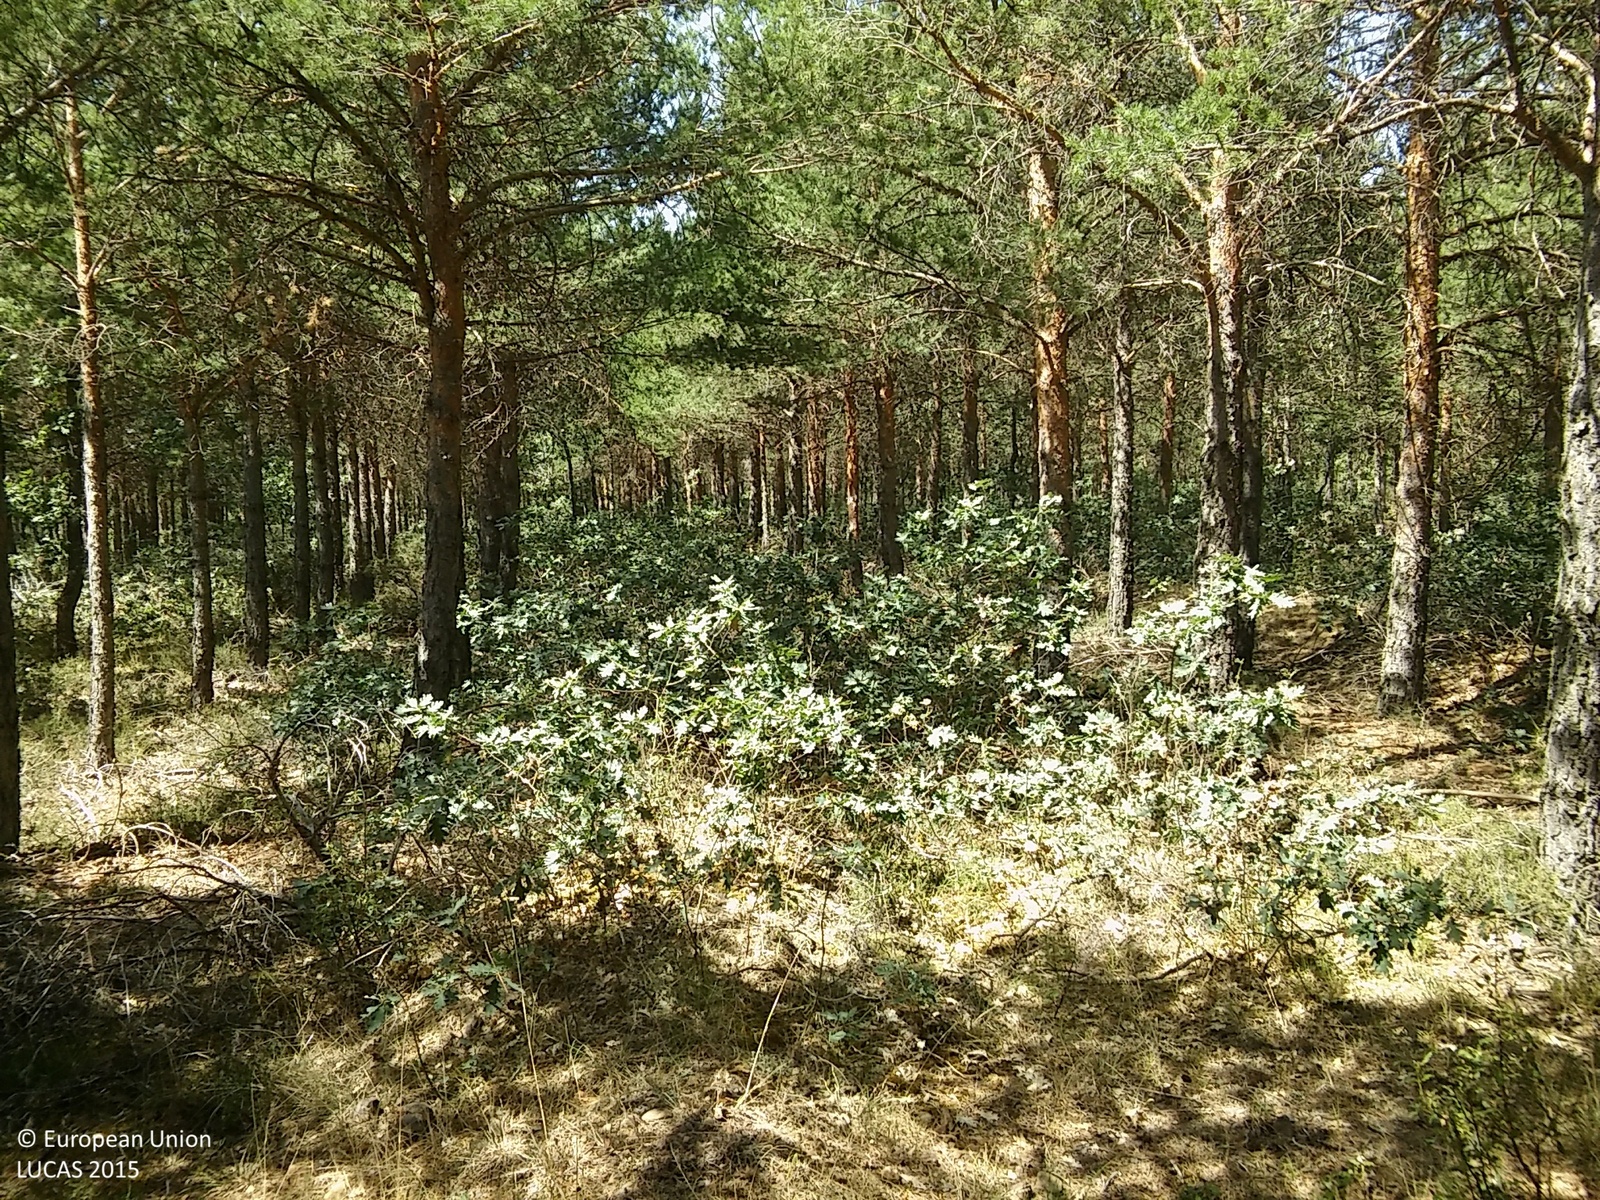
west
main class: Woodland
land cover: Pine dominated coniferous woodland
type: coniferous forest of the mediterranean region
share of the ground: 50 - 75 %
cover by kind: coniferous forest trees 70 %, shrubs 15 %, herbaceous plants 10 %, unconsolidated bare surface 5 %
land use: Forestry
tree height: > 5 m
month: August
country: ES
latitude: 41.3235
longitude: -3.5105
